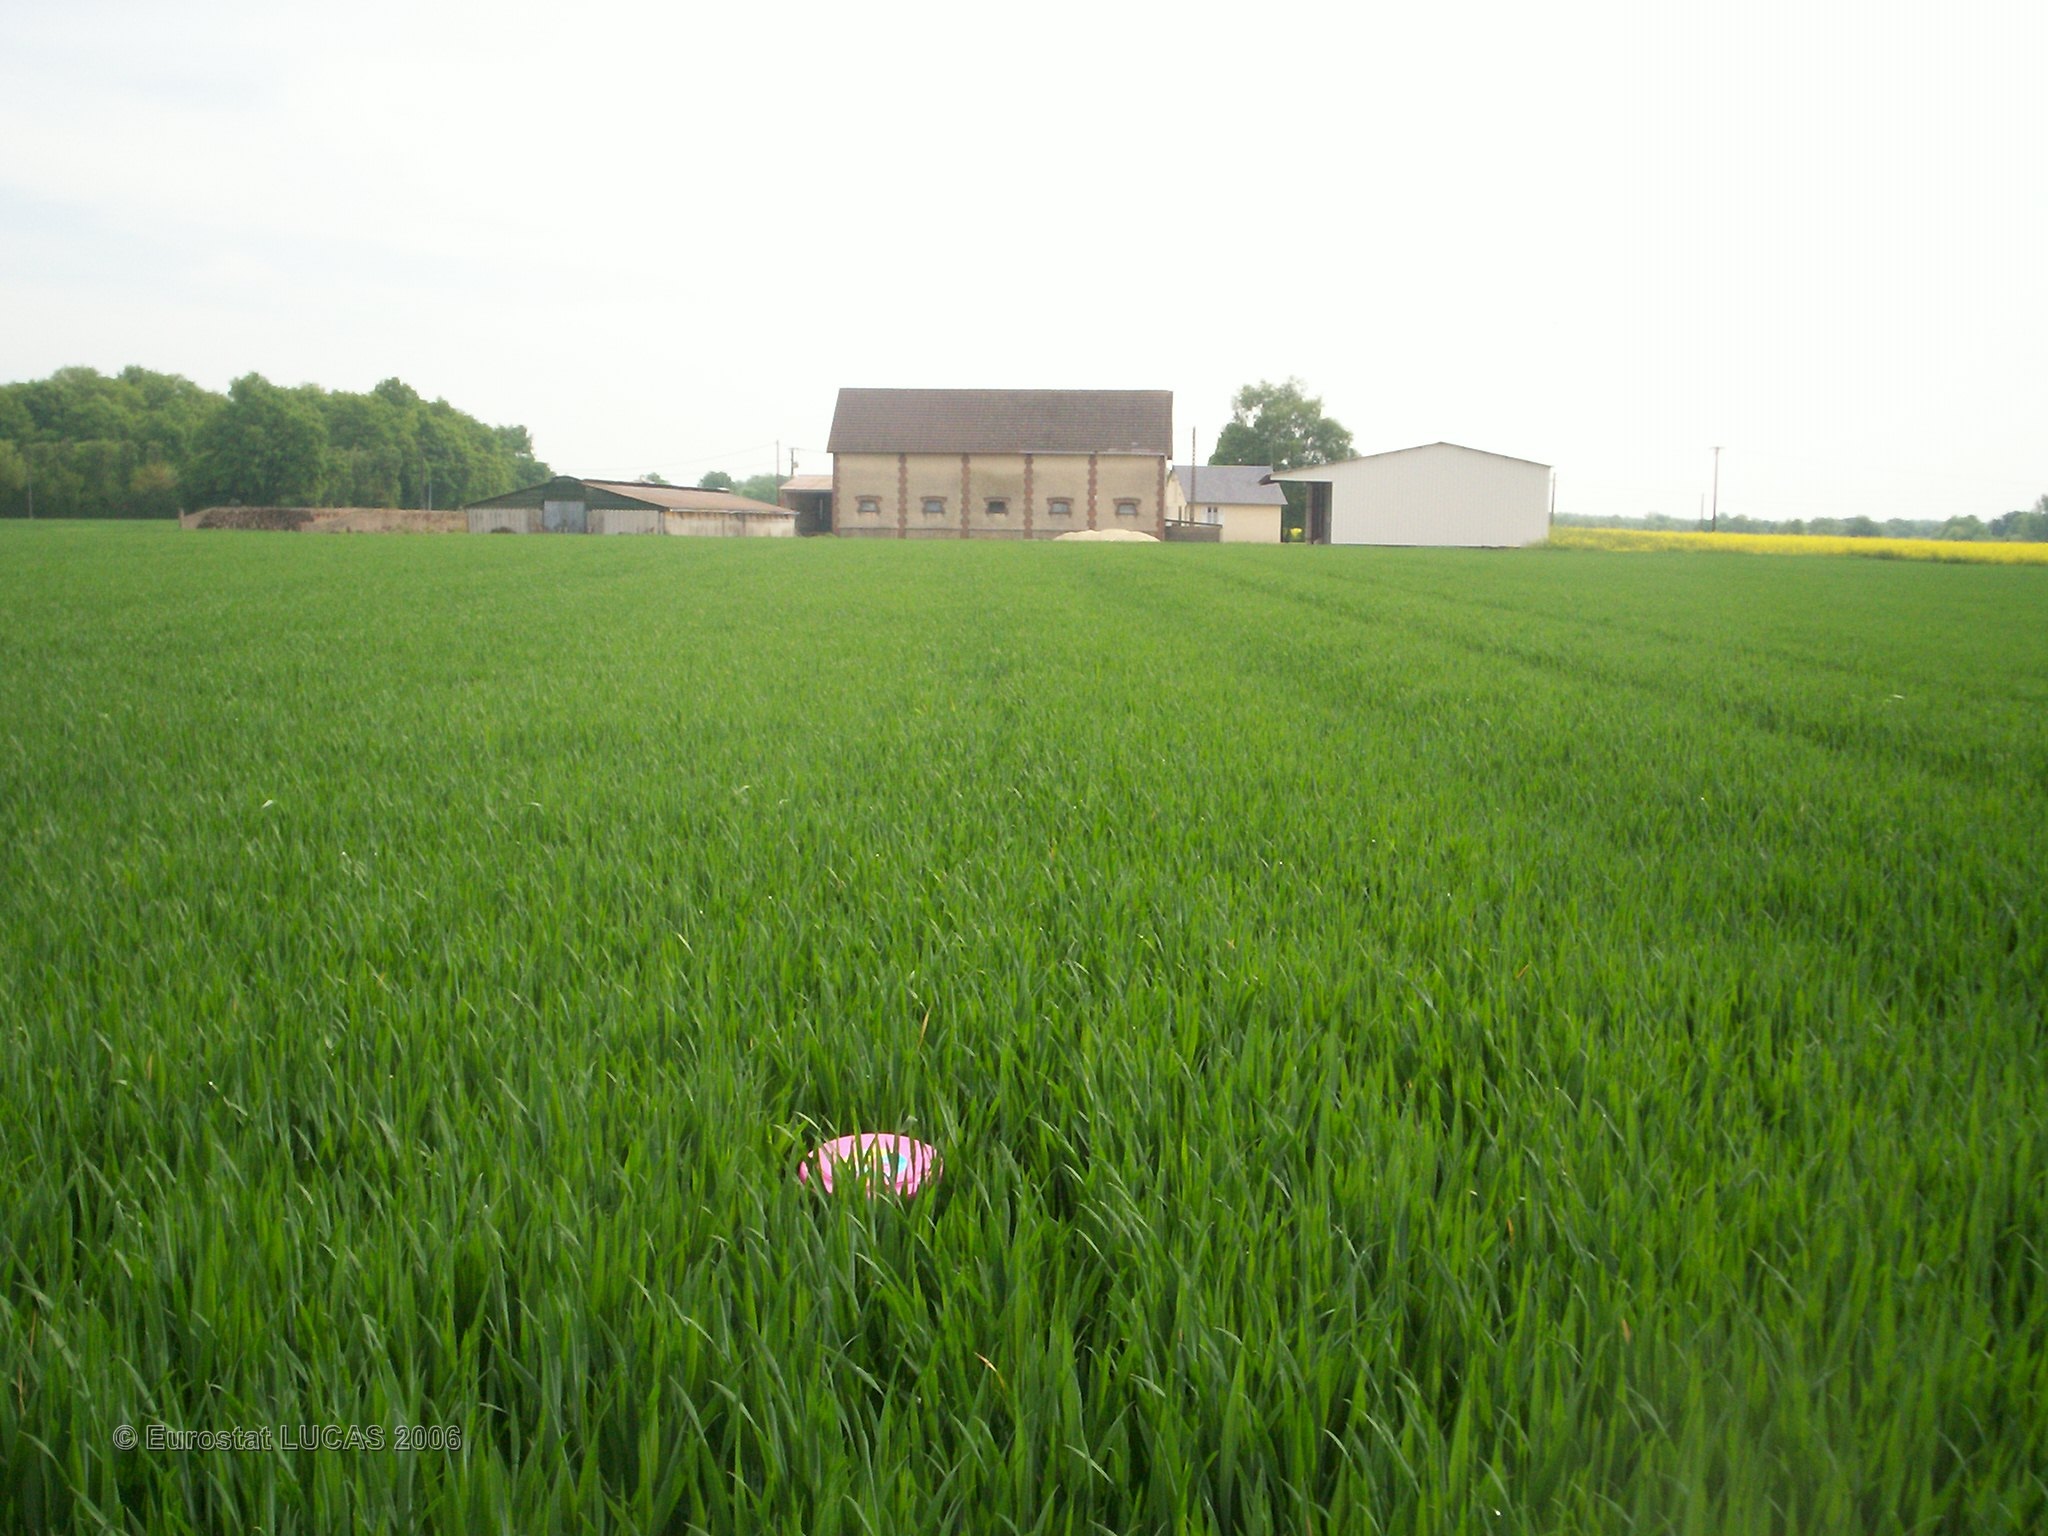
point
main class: Cropland
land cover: Barley
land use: Agriculture (excluding fallow land and kitchen gardens)
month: May
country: FR
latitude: 47.7475
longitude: 2.9912
